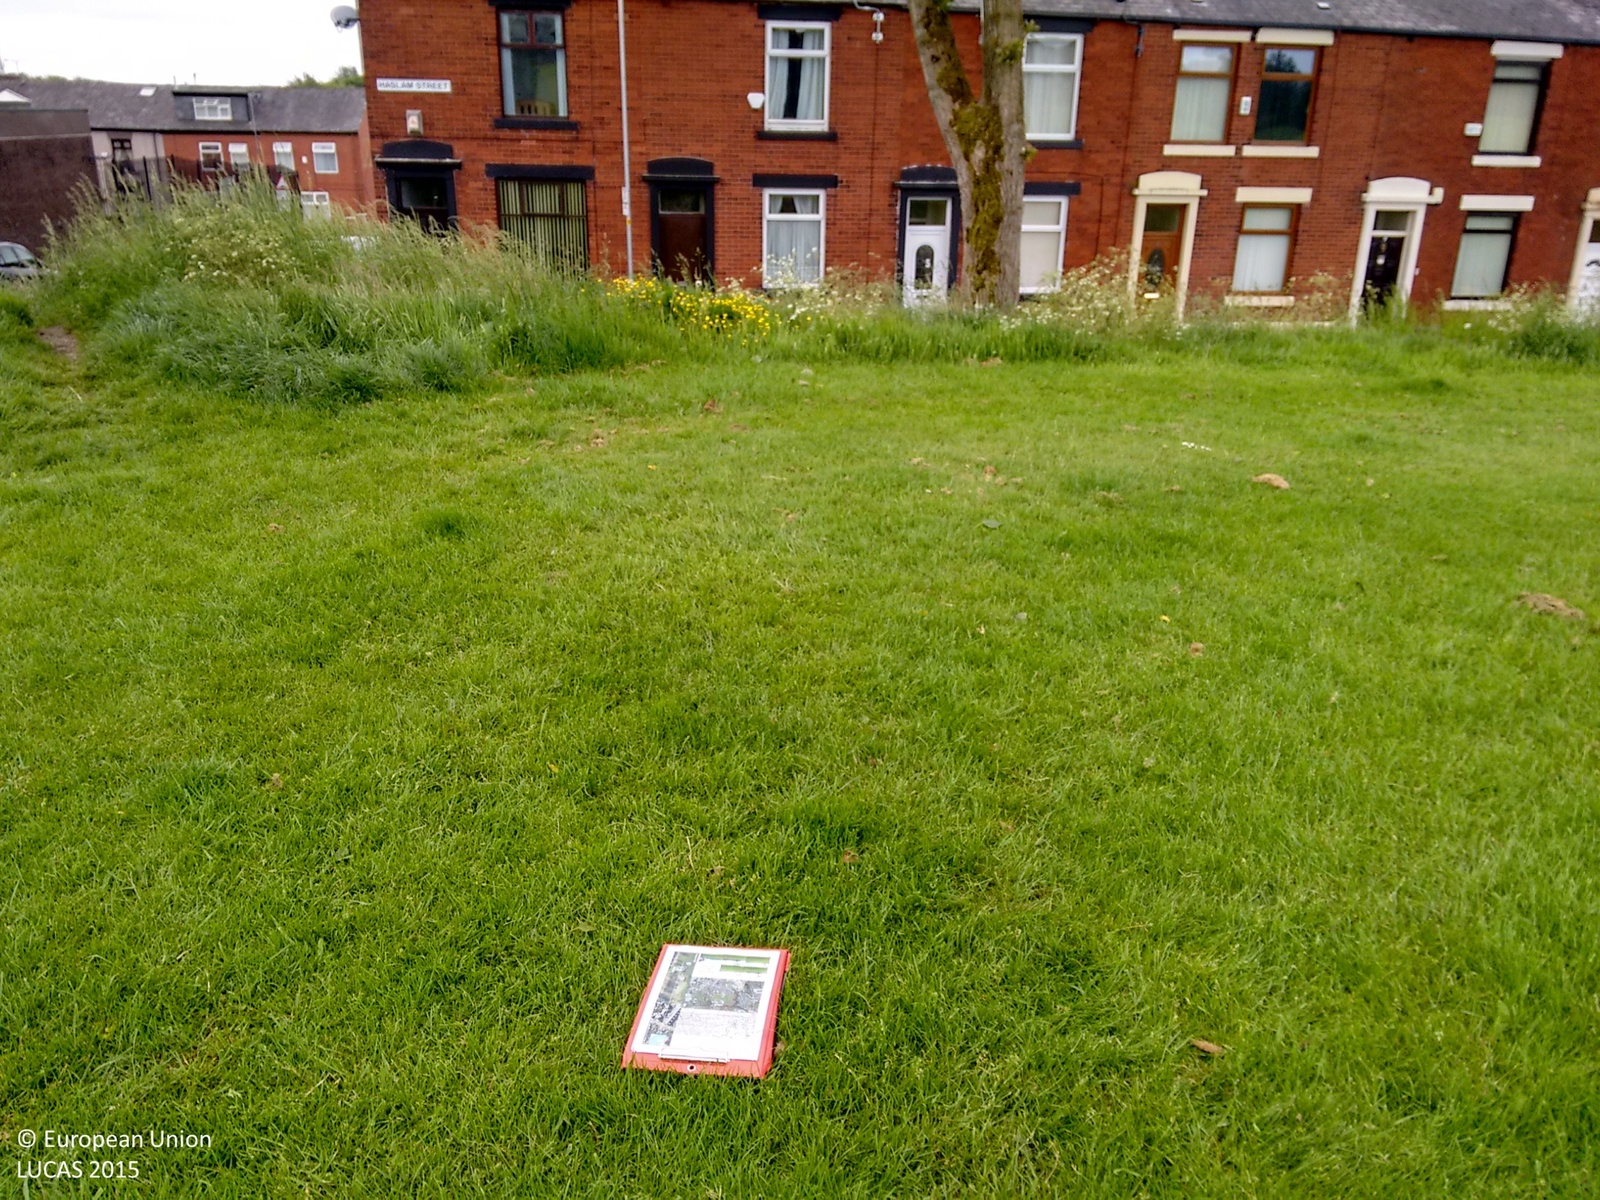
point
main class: Grassland
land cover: Grassland without tree/shrub cover
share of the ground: > 75 %
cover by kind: herbaceous plants 100 %
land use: Sport
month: June
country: GB
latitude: 53.6221
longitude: -2.1702
